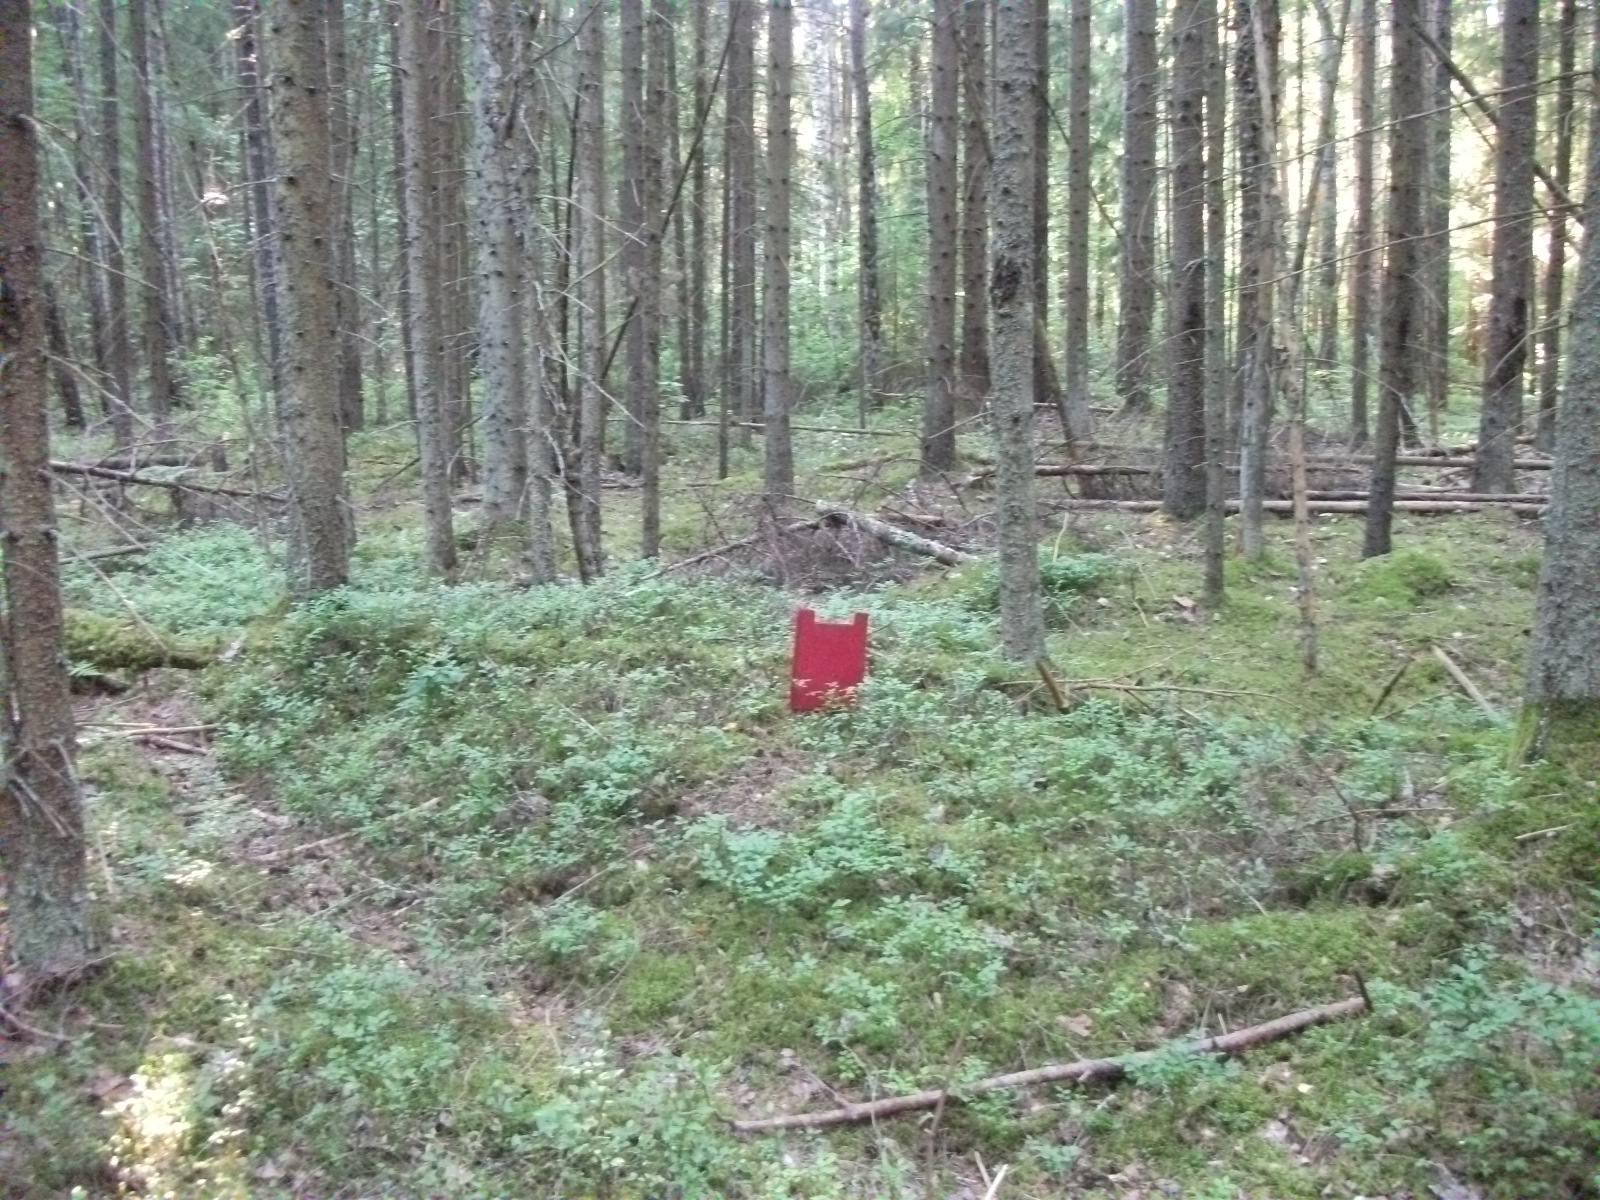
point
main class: Woodland
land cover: Spruce dominated coniferous woodland
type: hemiboreal forest and nemoral coniferous forest and mixed broadleaved-coniferous forest
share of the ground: > 75 %
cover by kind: coniferous forest trees 85 %, shrubs 10 %, broadleaved forest trees 5 %
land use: Forestry
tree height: > 5 m
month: July
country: LV
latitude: 56.8193
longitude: 26.6487
